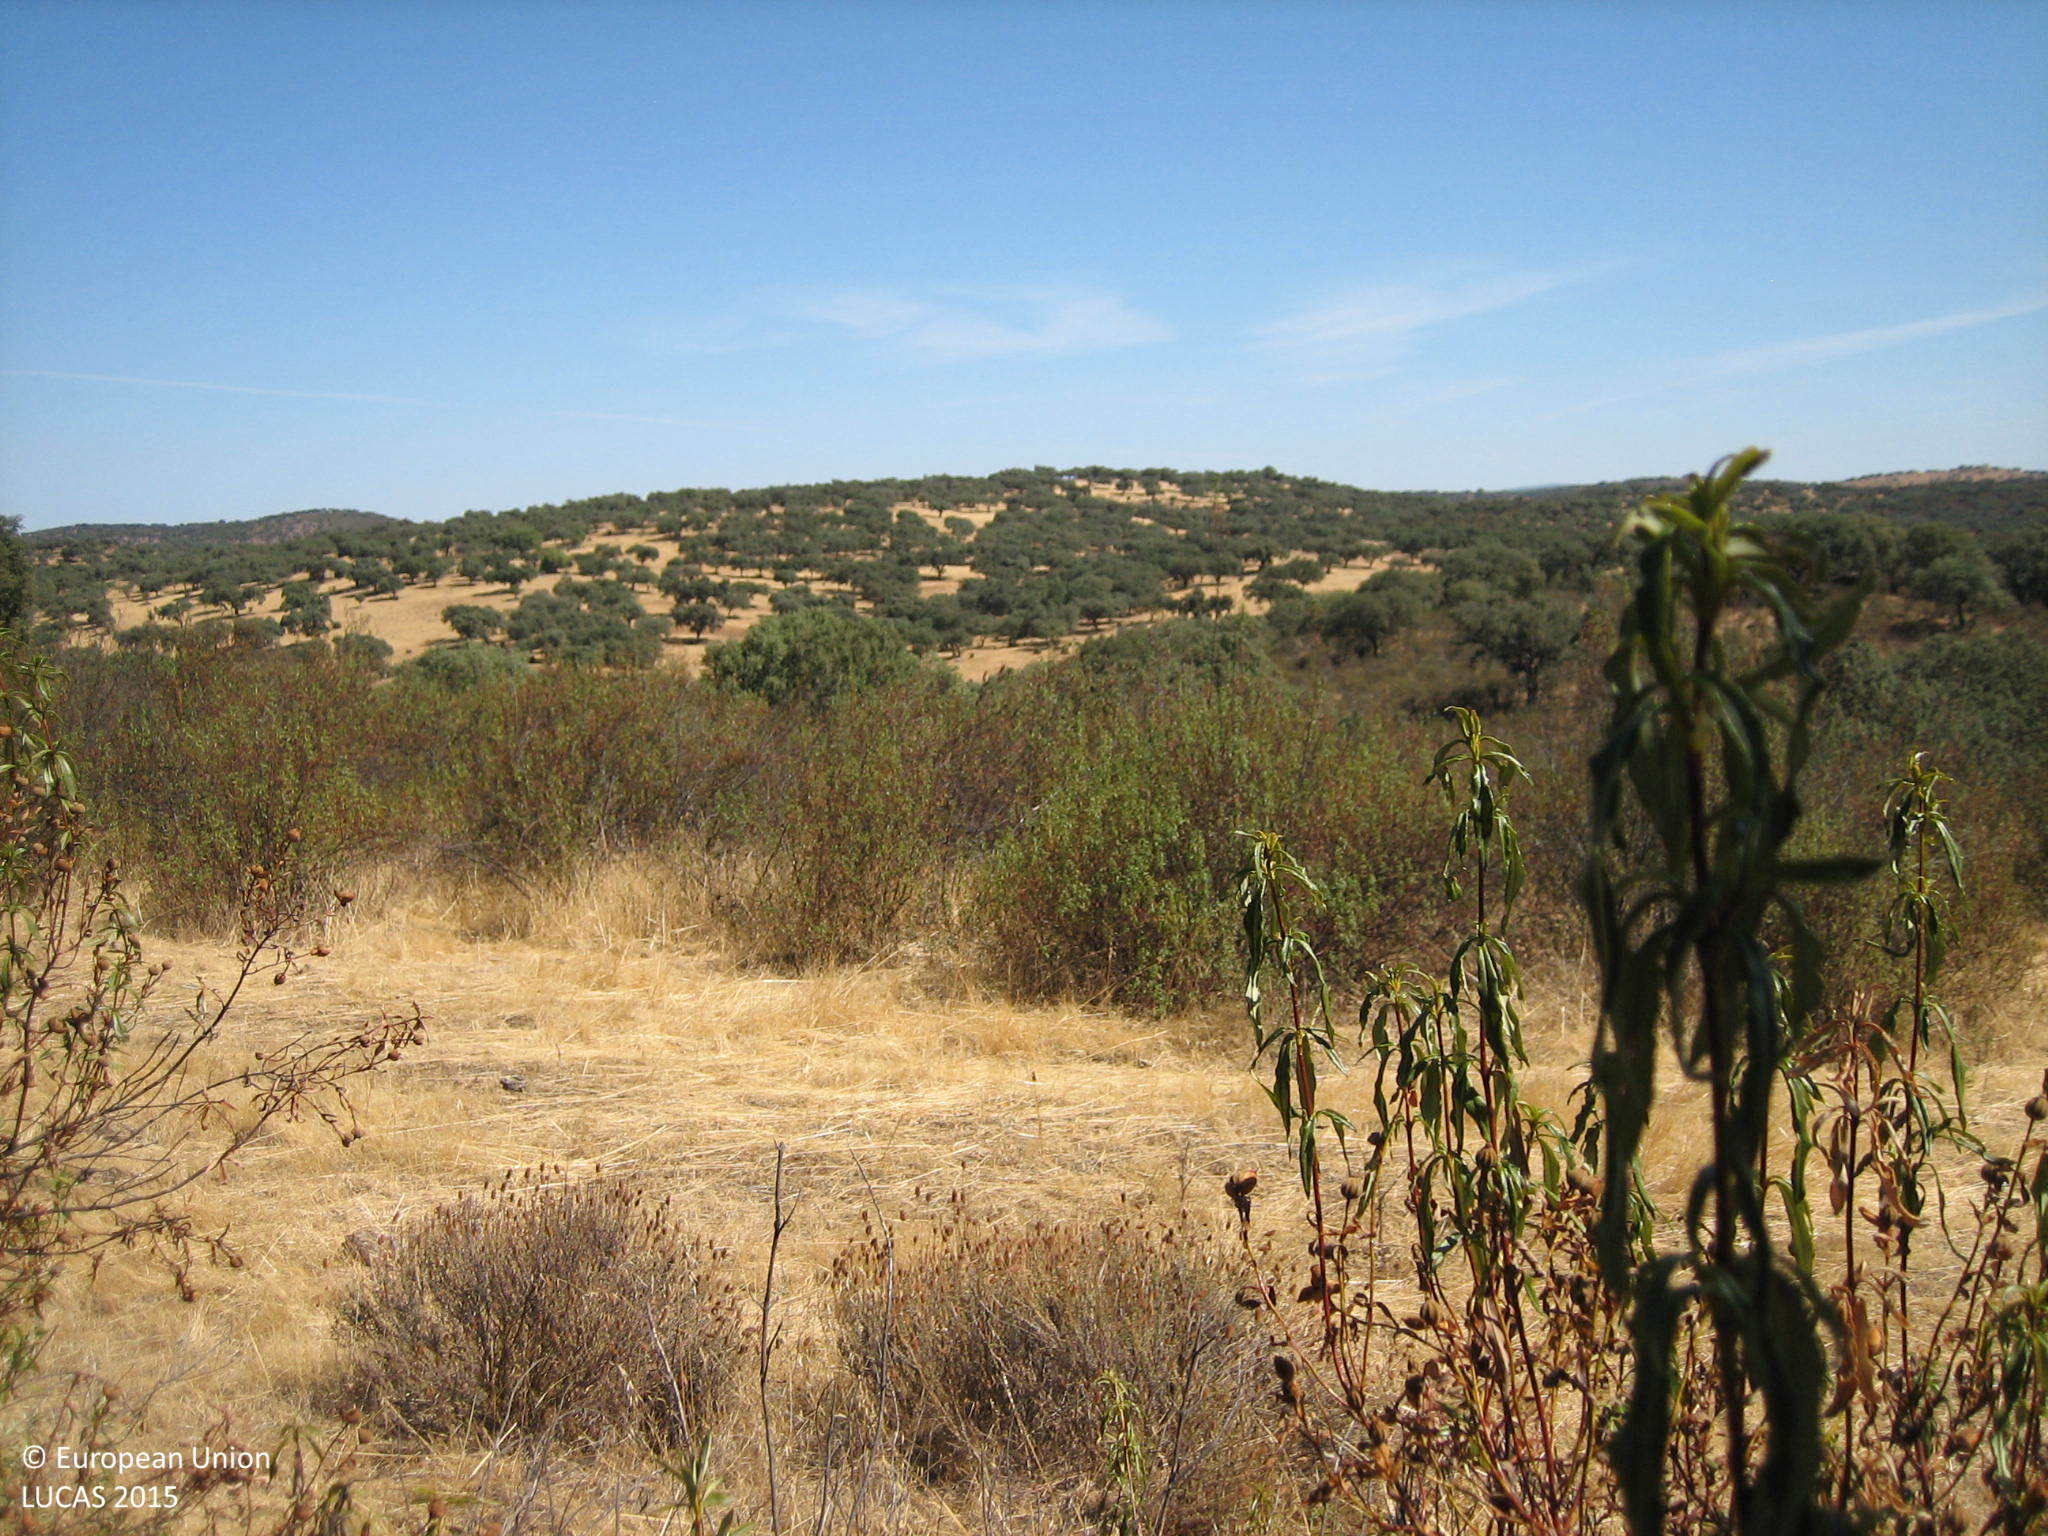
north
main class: Shrubland
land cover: Shrubland with sparse tree cover
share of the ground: 50 - 75 %
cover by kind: shrubs 60 %, herbaceous plants 35 %, broadleaved forest trees 5 %
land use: Agriculture (excluding fallow land and kitchen gardens)
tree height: < 5 m
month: August
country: ES
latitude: 38.4546
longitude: -7.2217
